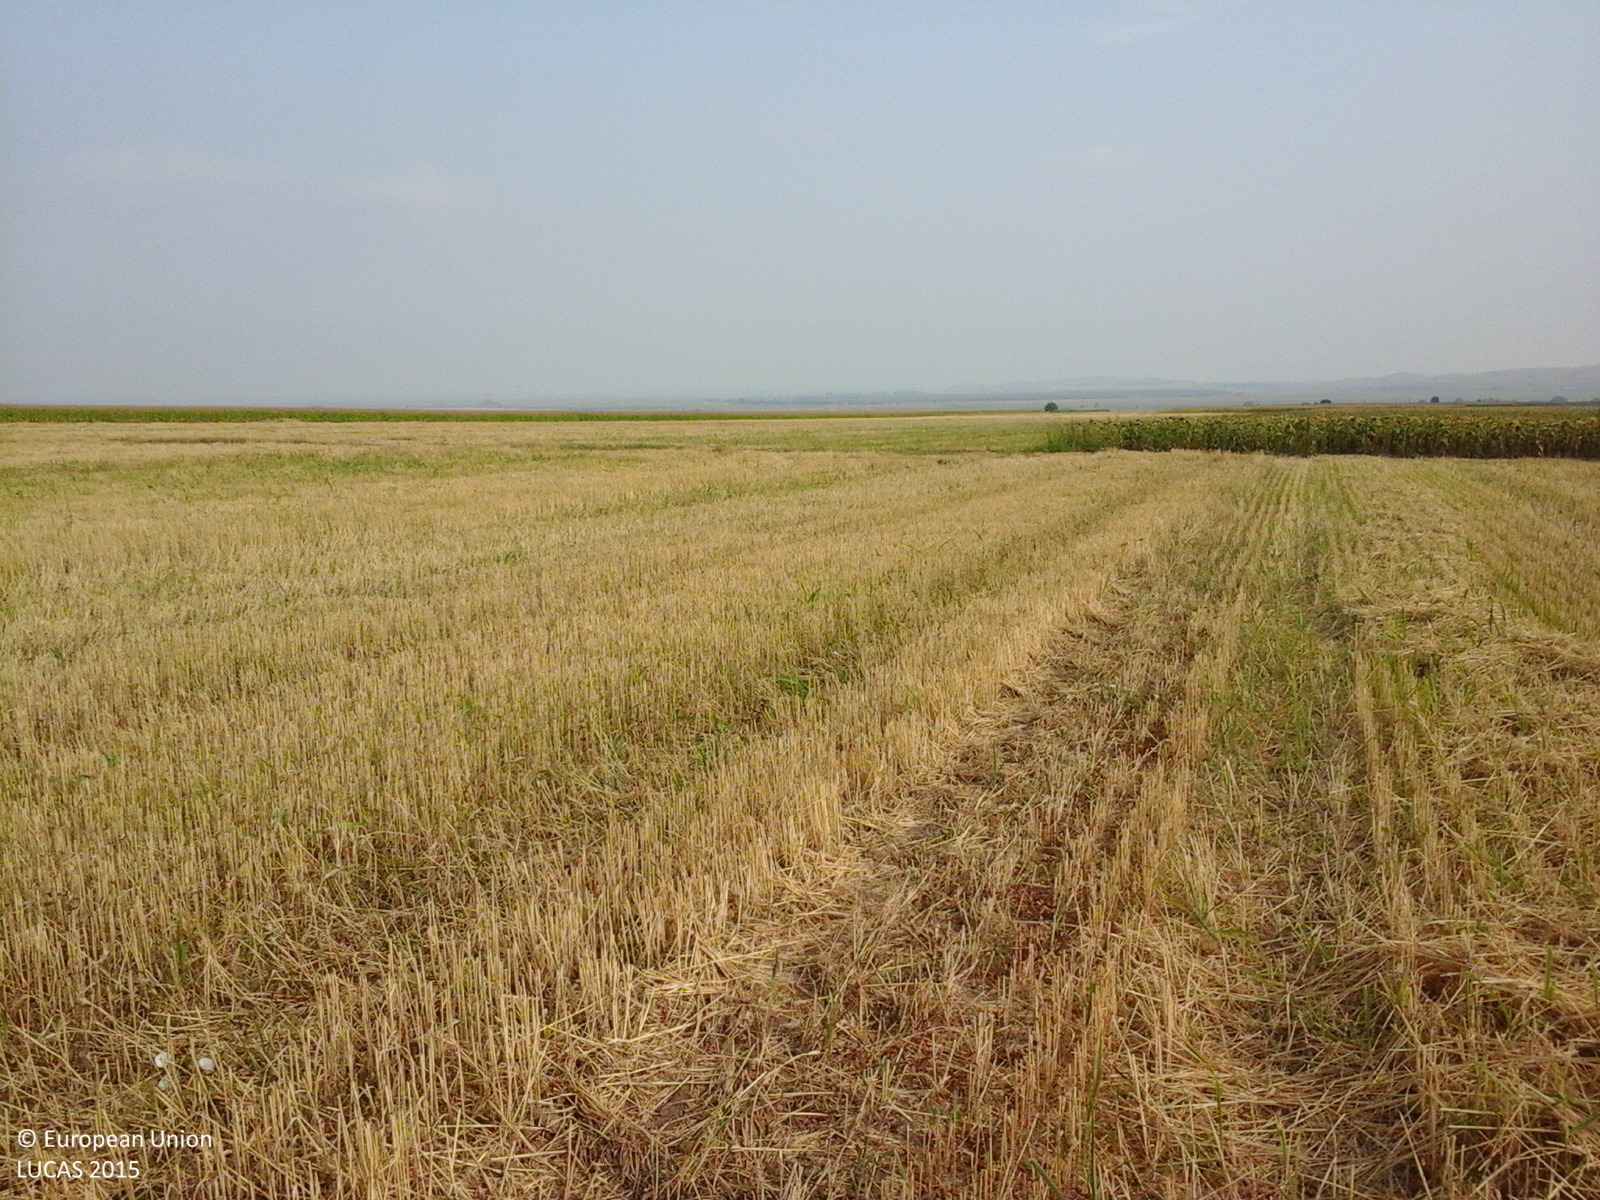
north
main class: Cropland
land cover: Durum wheat
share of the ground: > 75 %
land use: Agriculture (excluding fallow land and kitchen gardens)
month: July
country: RO
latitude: 45.2823
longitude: 28.1336
